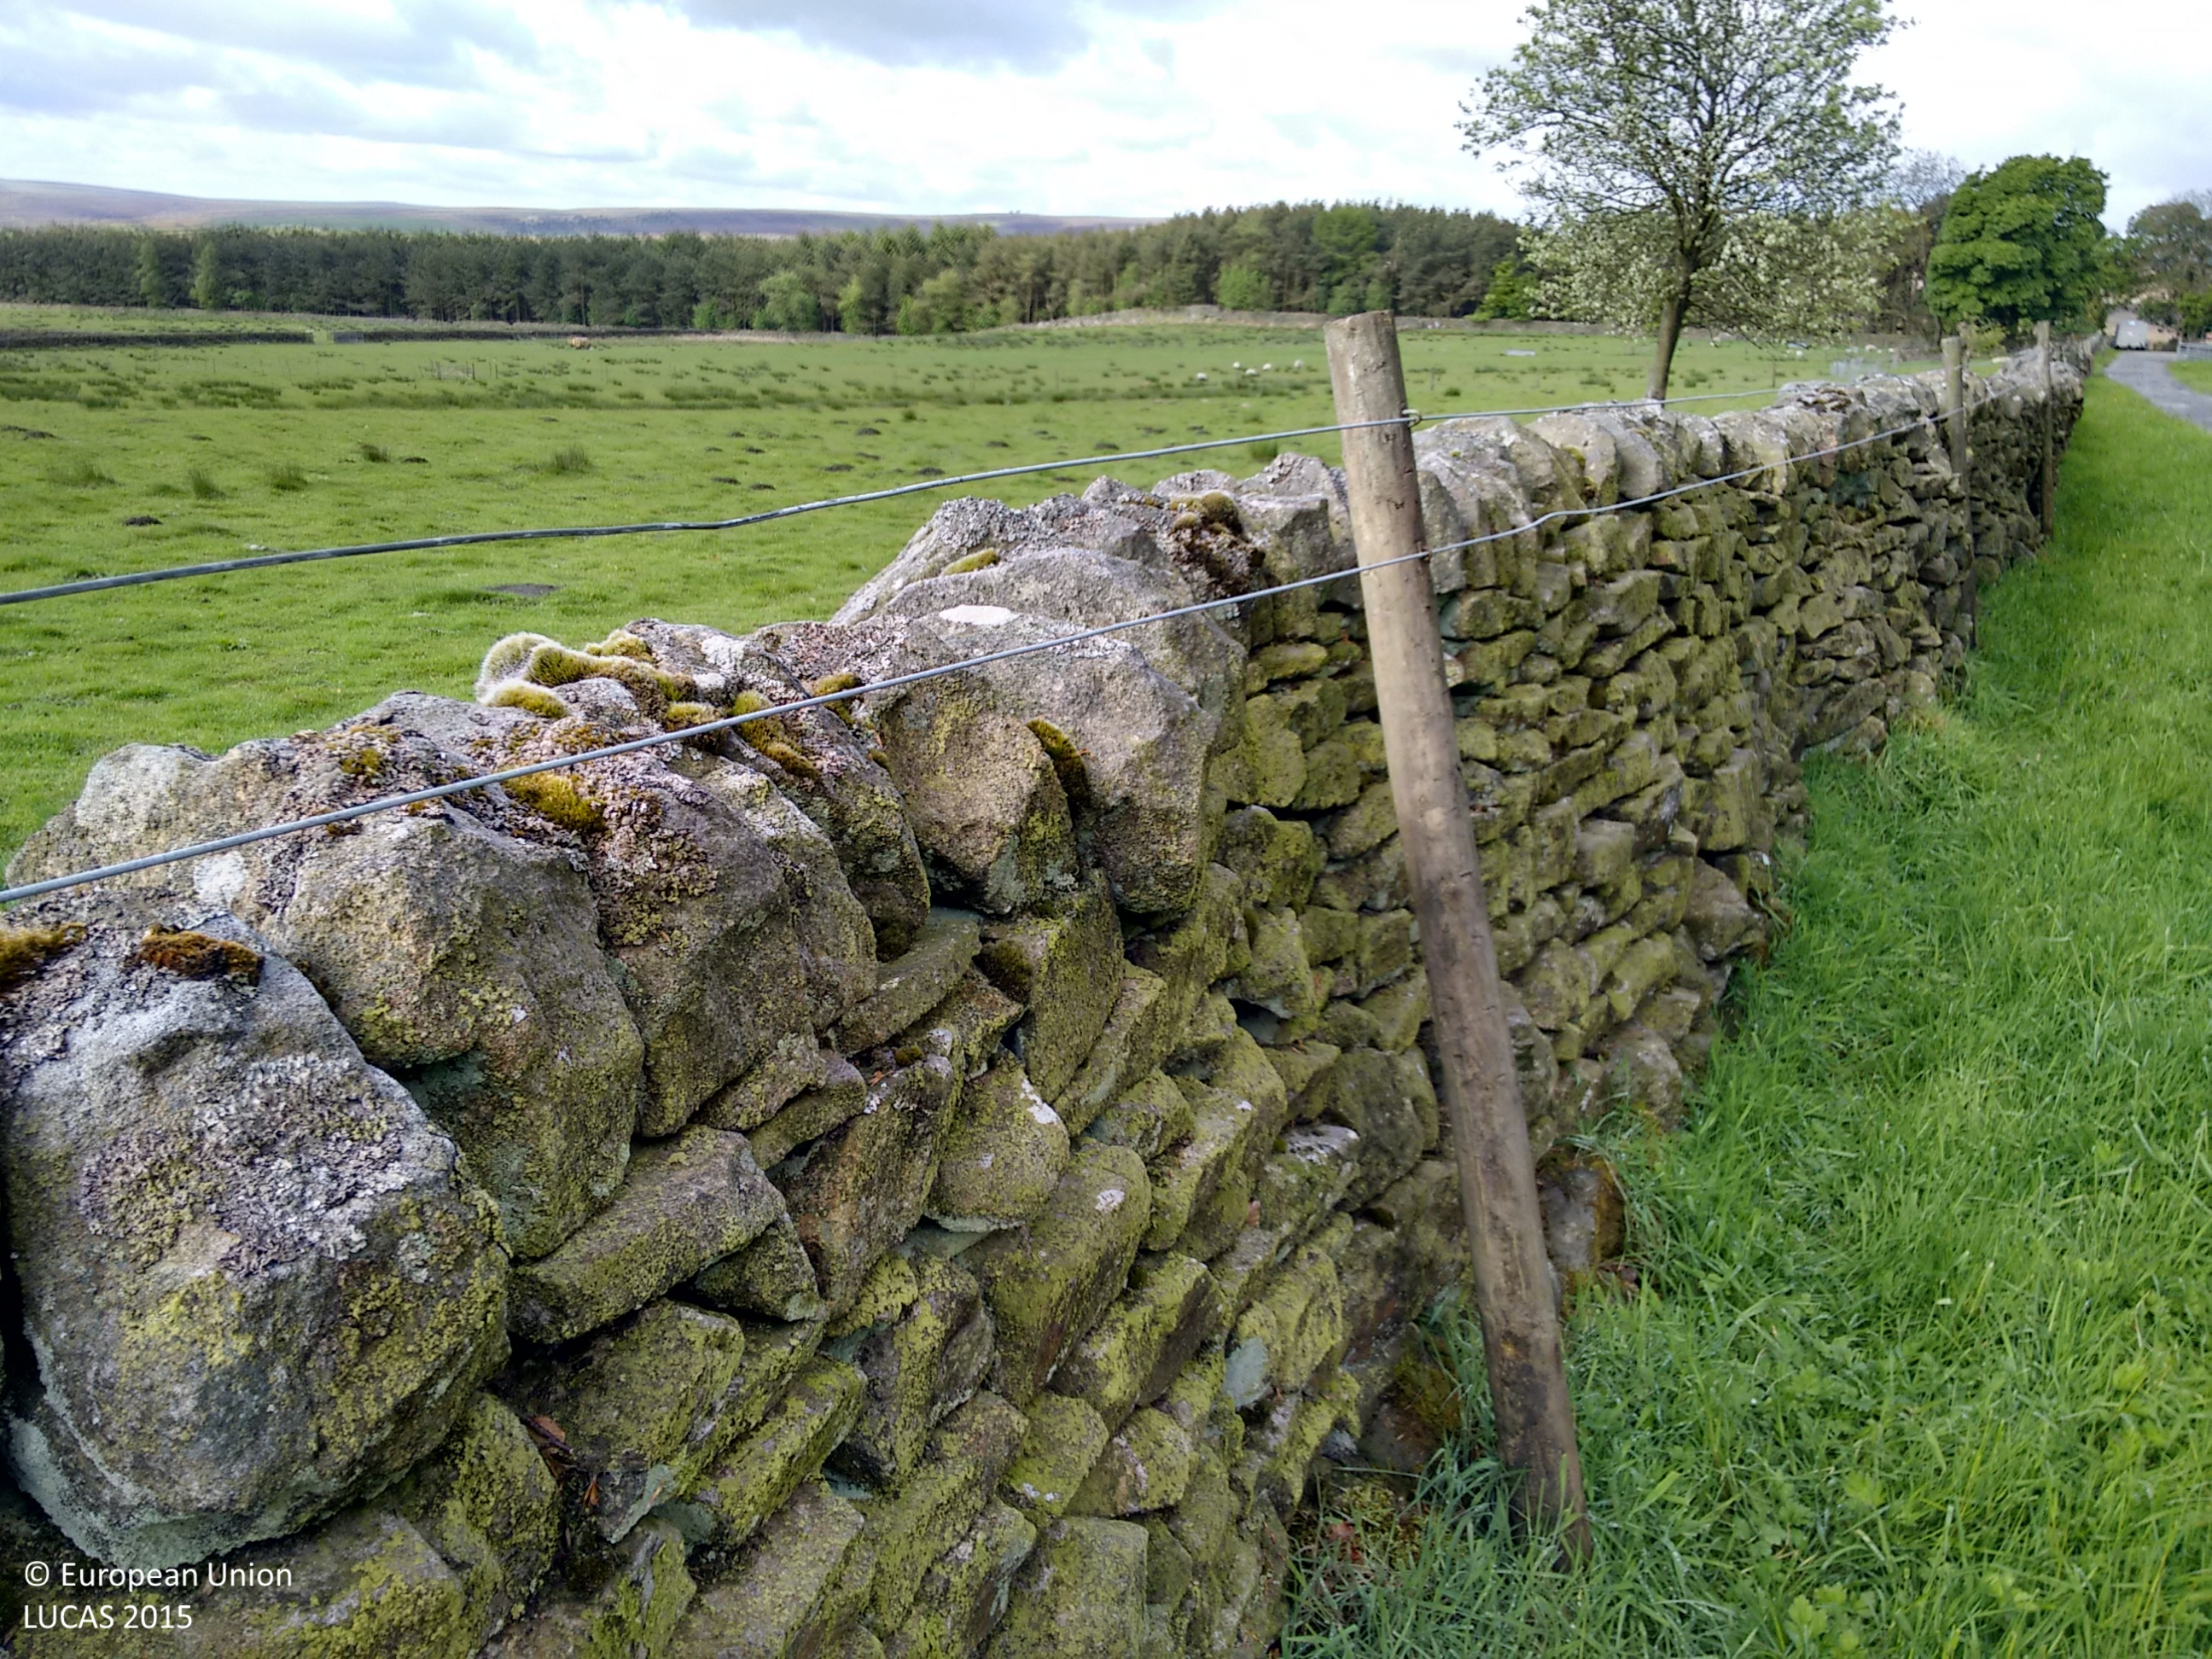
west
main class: Grassland
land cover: Grassland without tree/shrub cover
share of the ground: > 75 %
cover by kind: herbaceous plants 100 %
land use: Agriculture (excluding fallow land and kitchen gardens)
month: June
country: GB
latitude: 54.0410
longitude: -1.7967
